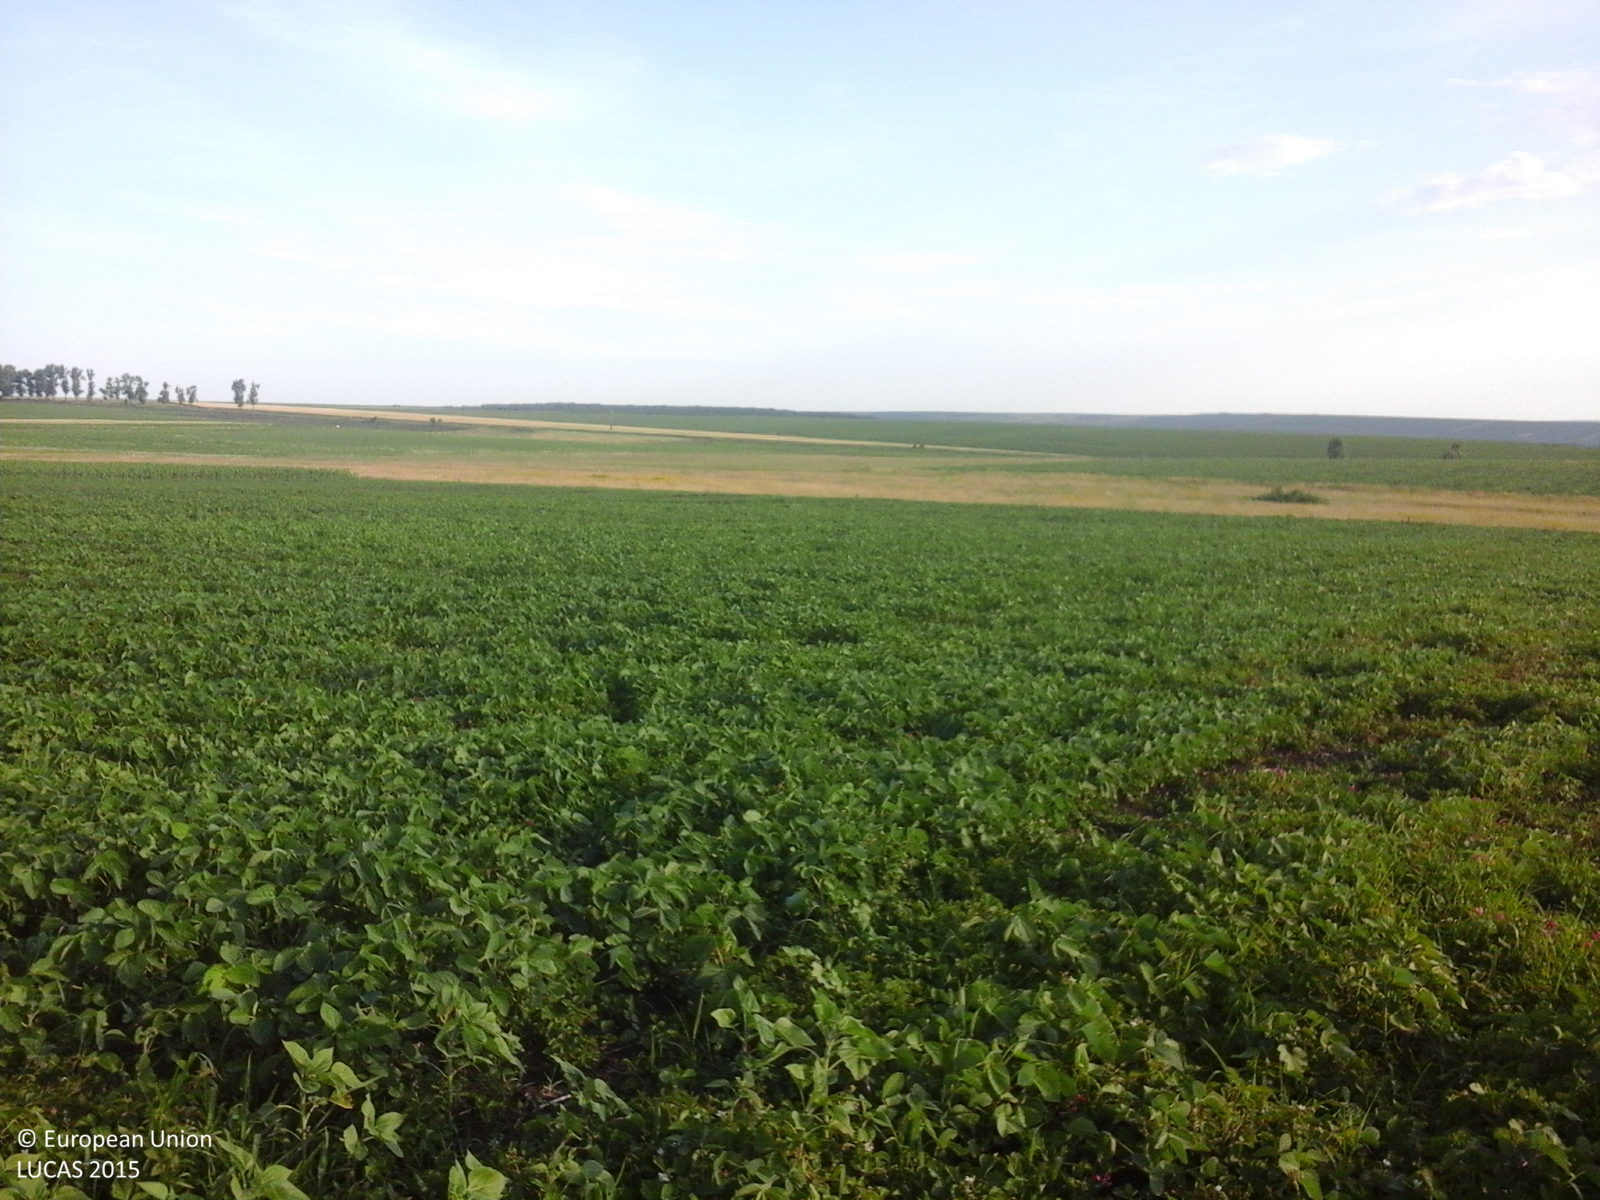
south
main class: Cropland
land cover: Soya
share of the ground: > 75 %
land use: Agriculture (excluding fallow land and kitchen gardens)
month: June
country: RO
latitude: 48.1033
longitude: 26.7660
